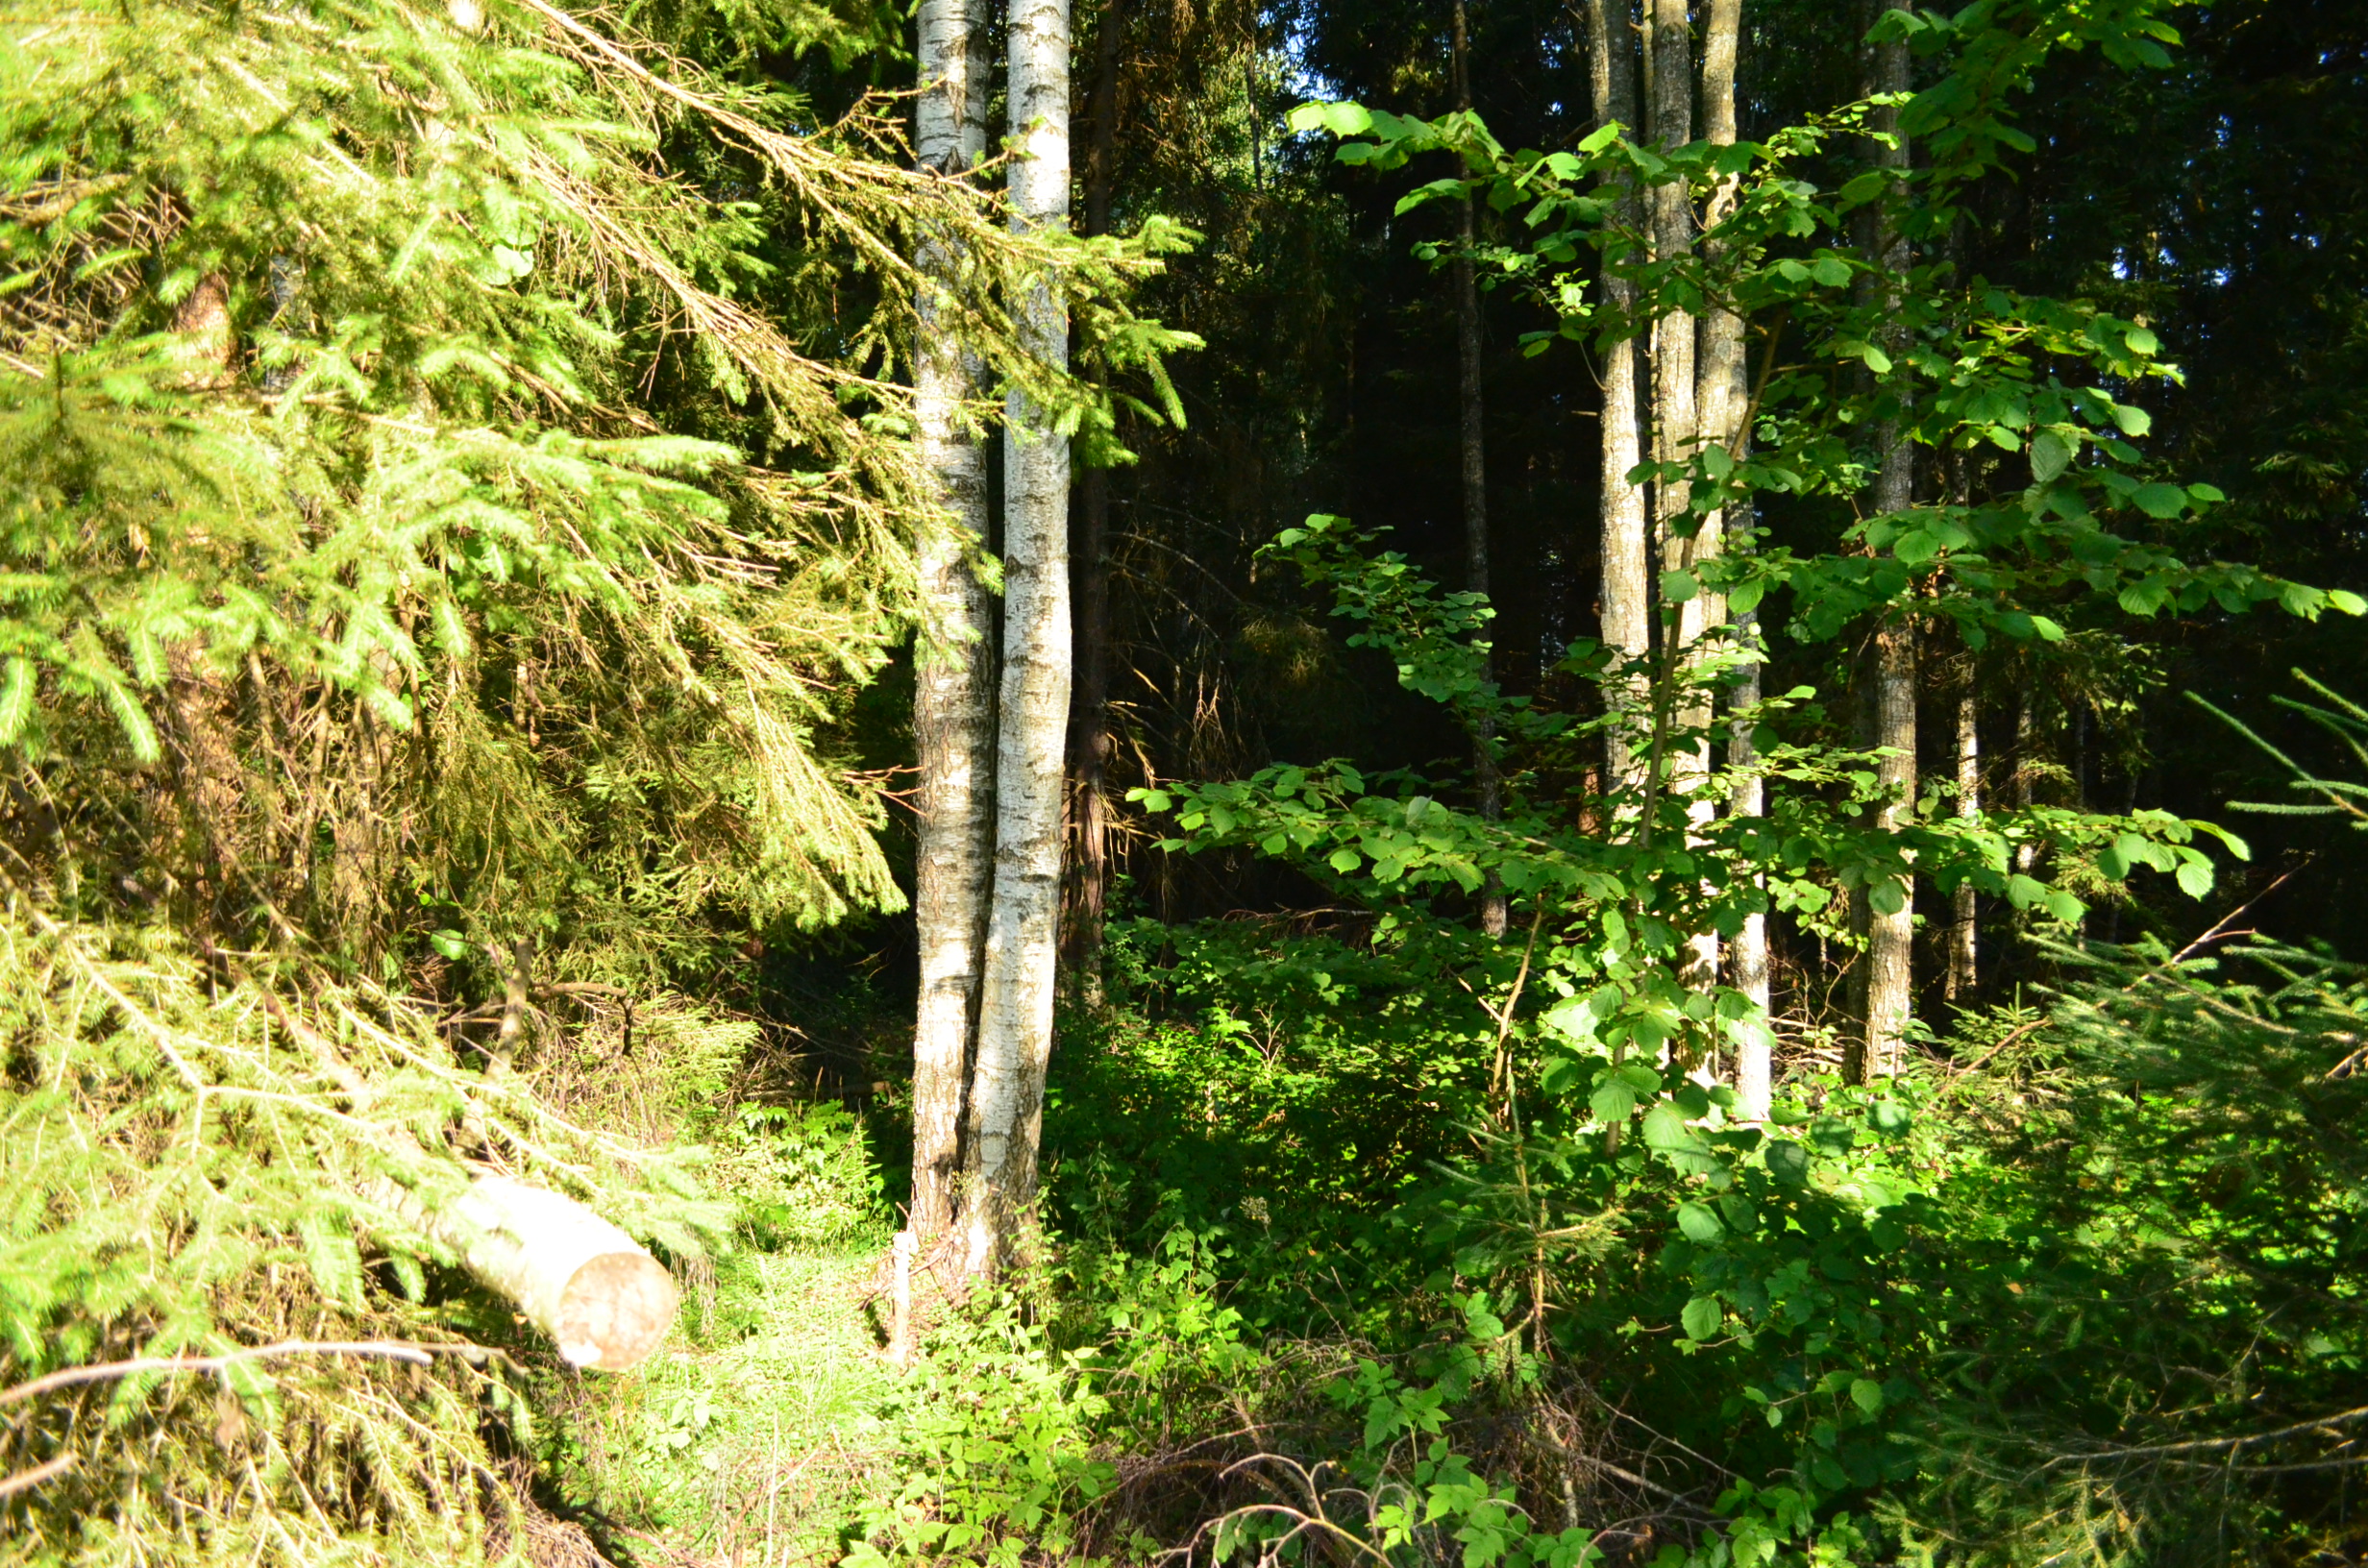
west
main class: Woodland
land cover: Spruce dominated mixed woodland
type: hemiboreal forest and nemoral coniferous forest and mixed broadleaved-coniferous forest
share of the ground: 50 - 75 %
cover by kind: broadleaved forest trees 30 %, coniferous forest trees 25 %, herbaceous plants 25 %, shrubs 20 %
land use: Forestry
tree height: > 5 m
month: August
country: LV
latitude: 57.6198
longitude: 22.2533
